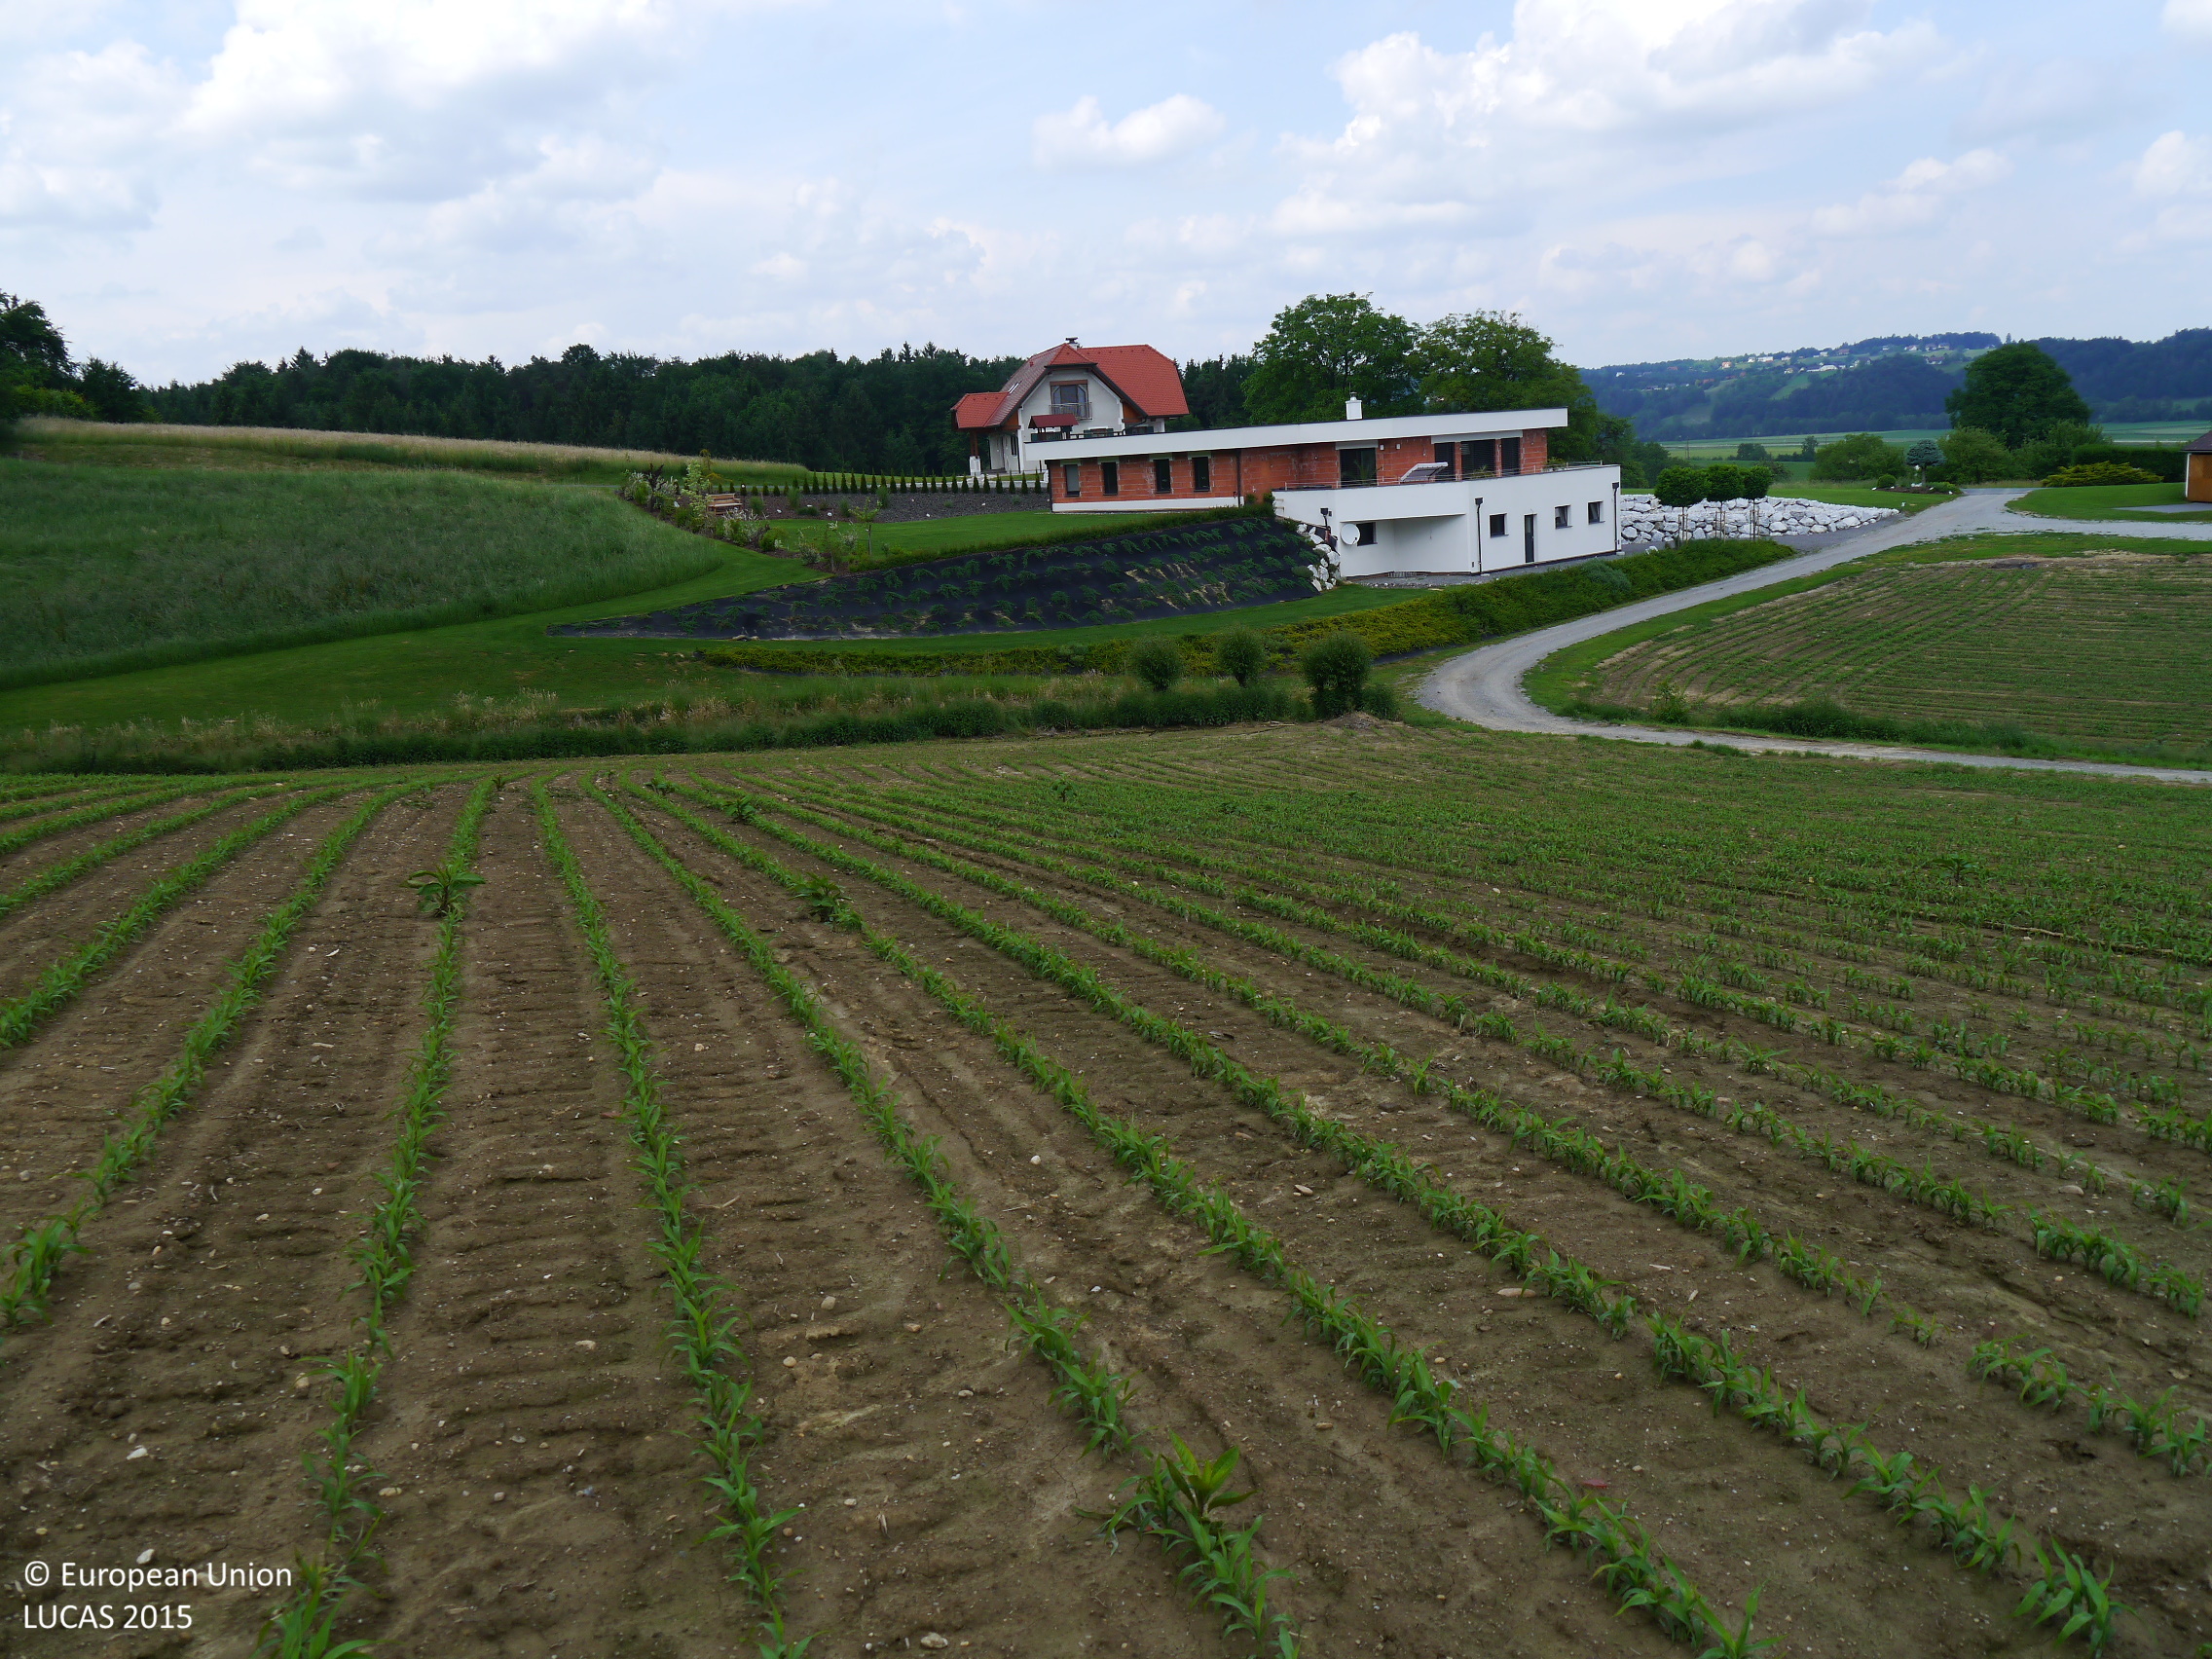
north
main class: Cropland
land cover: Maize
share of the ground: 10 - 25 %
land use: Agriculture (excluding fallow land and kitchen gardens)
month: June
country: AT
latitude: 46.8889
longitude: 15.6301
